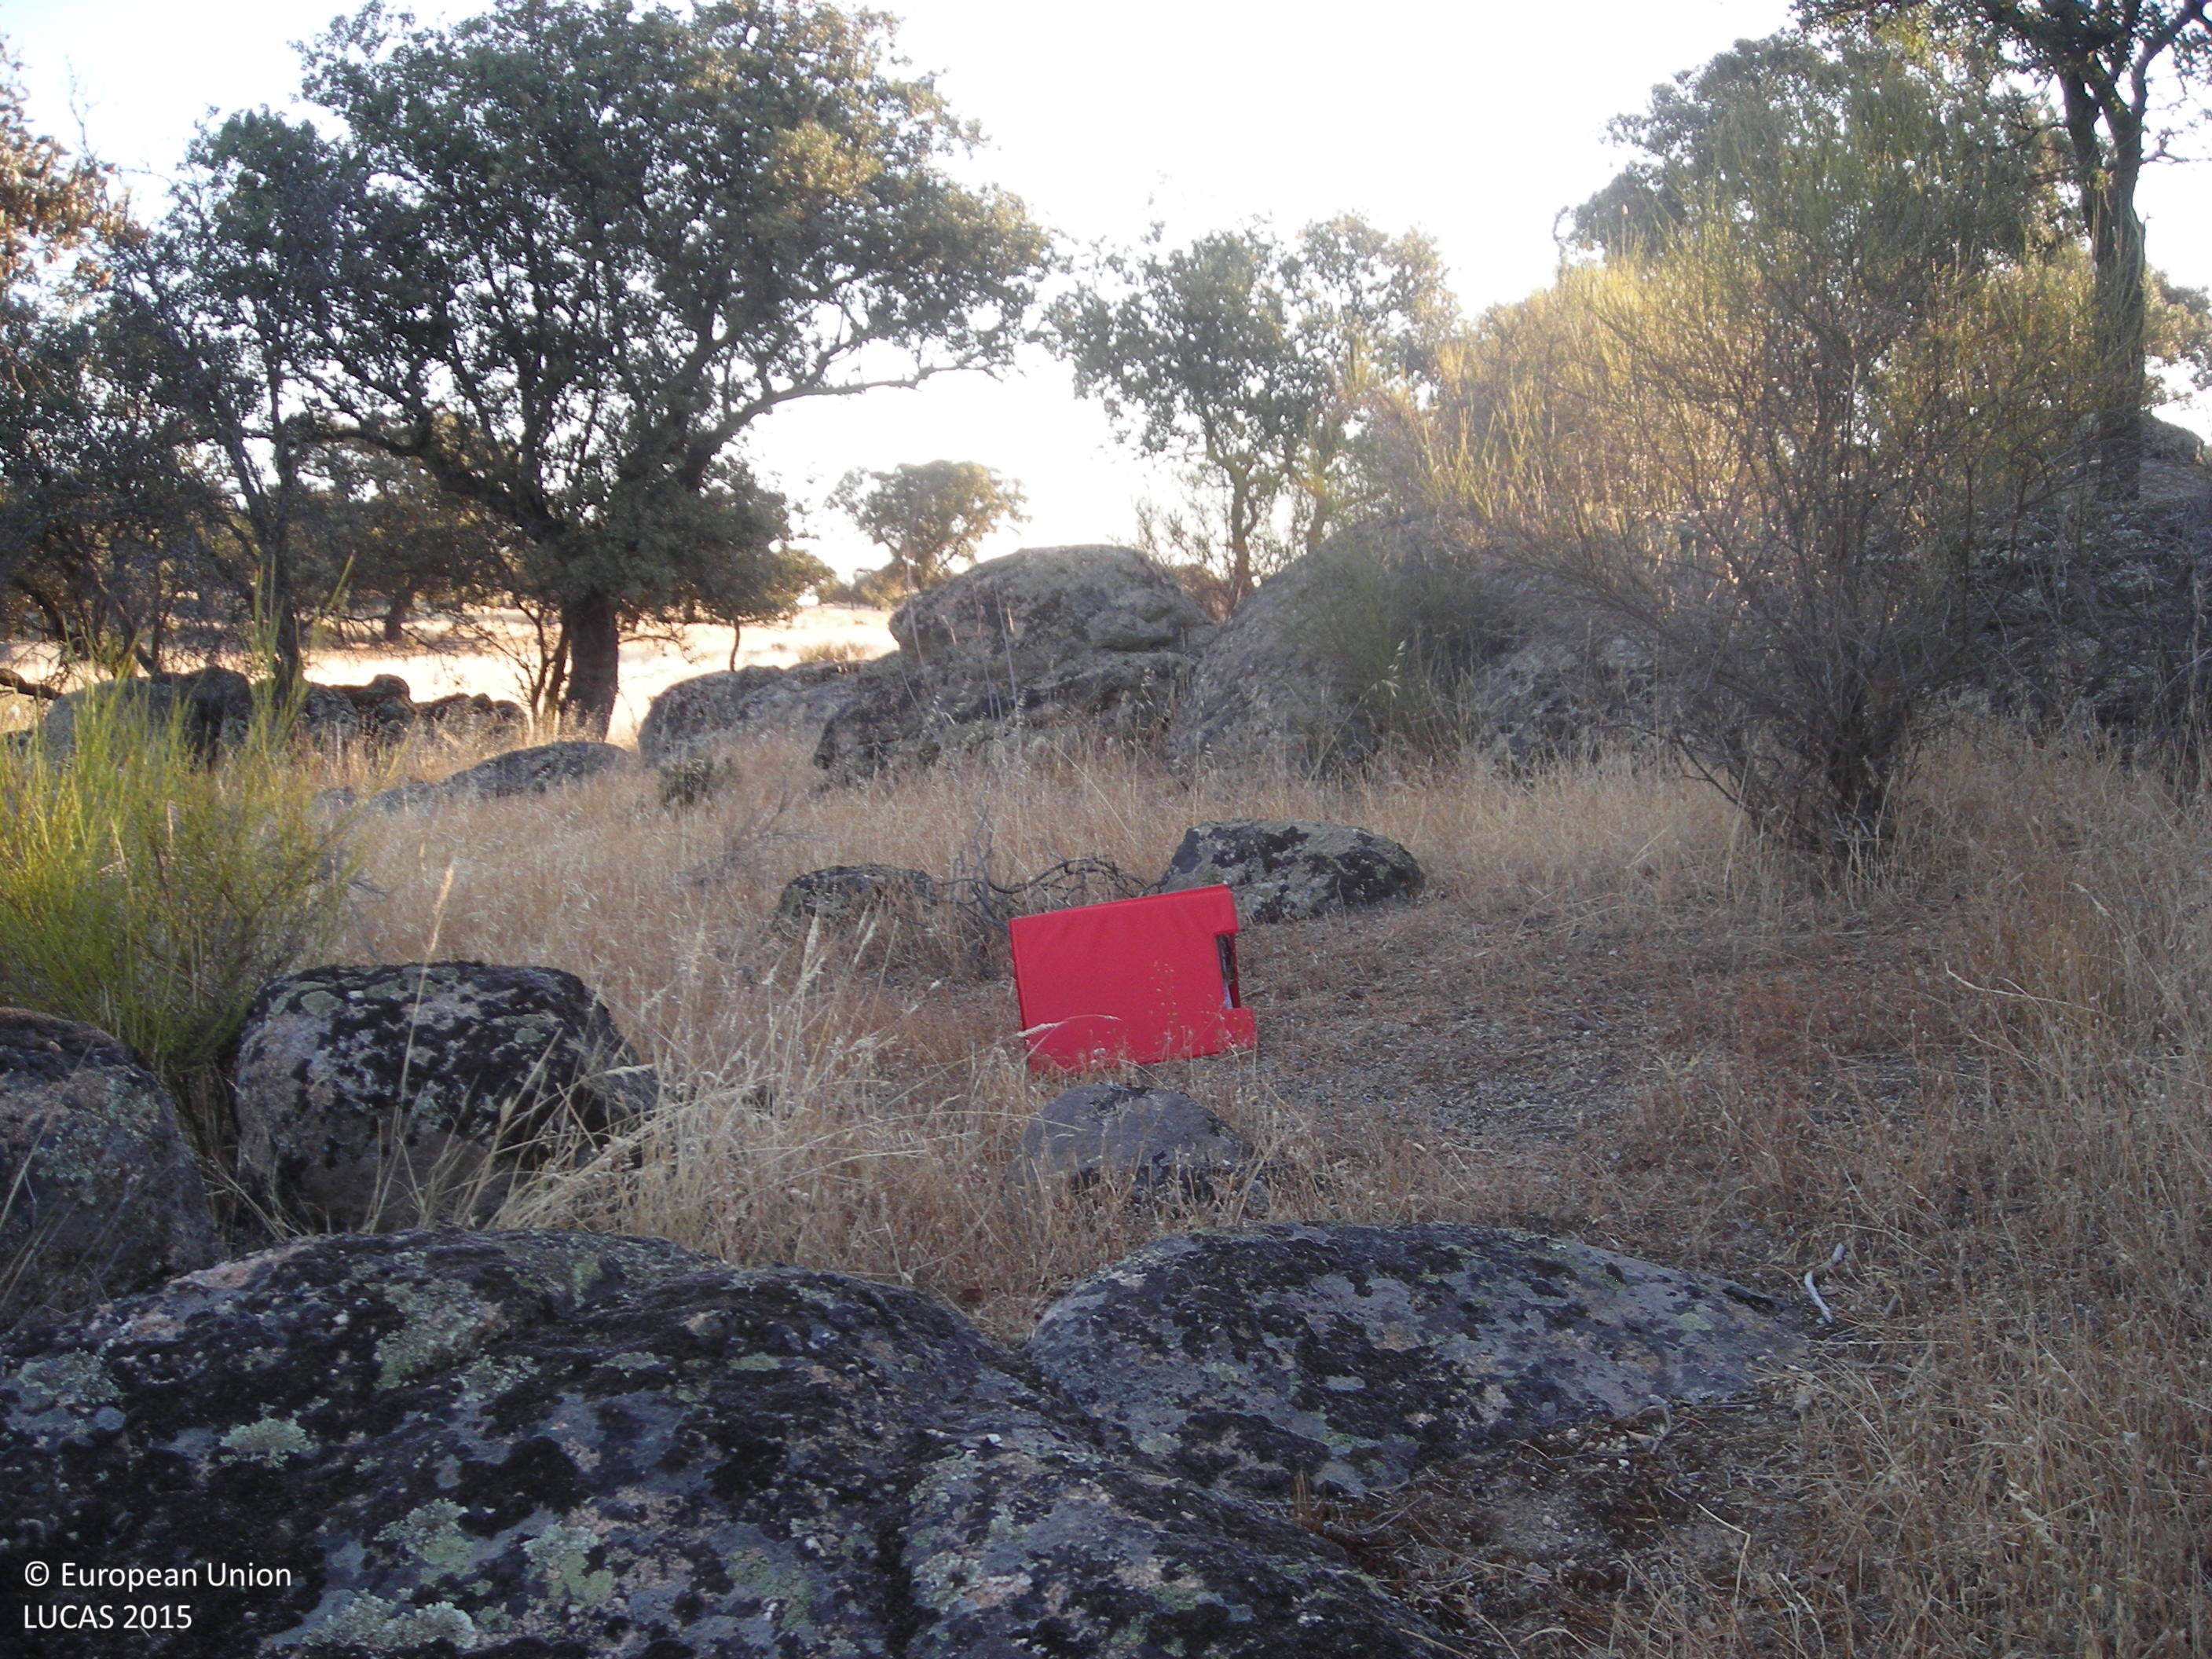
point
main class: Woodland
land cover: Broadleaved woodland
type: broadleaved evergreen forest
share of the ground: 10 - 25 %
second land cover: Grassland without tree/shrub cover
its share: > 75 %
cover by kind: shrubs 85 %, broadleaved forest trees 15 %
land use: Forestry
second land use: Agriculture (excluding fallow land and kitchen gardens)
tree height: > 5 m
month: July
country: ES
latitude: 38.8812
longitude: -5.8285
